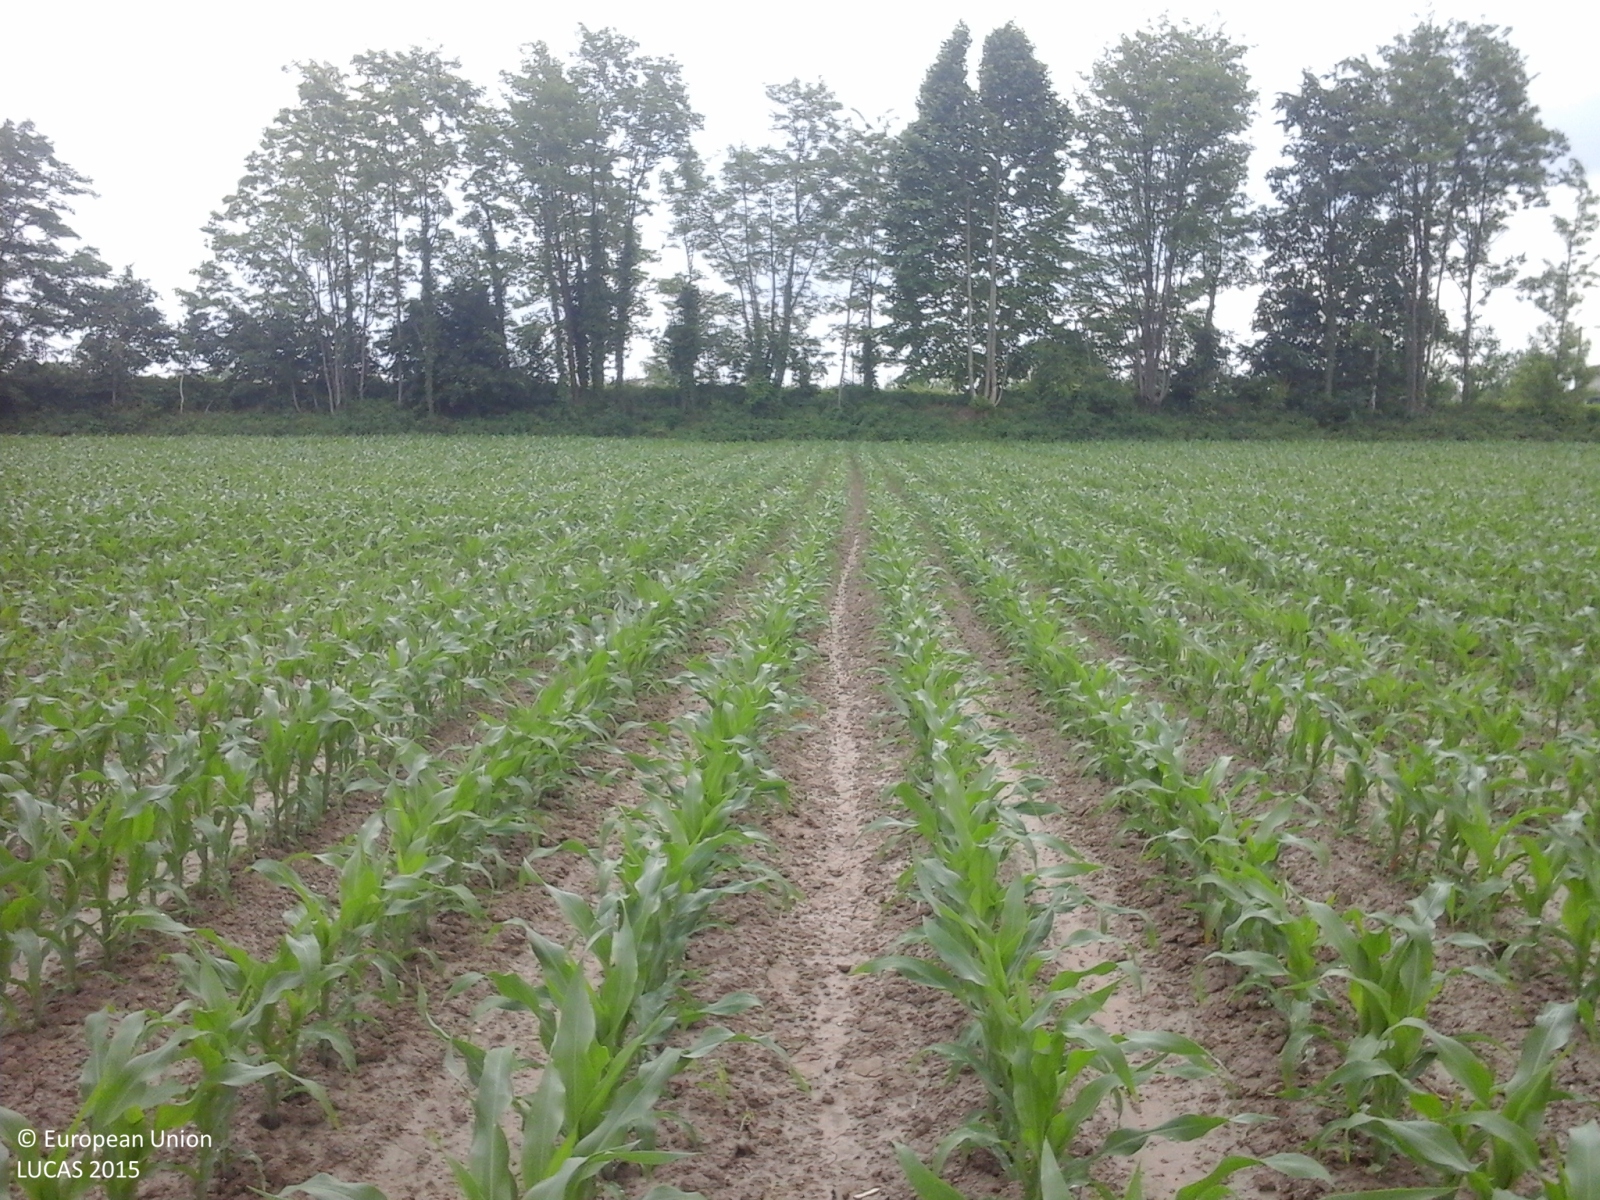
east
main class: Cropland
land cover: Maize
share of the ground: 25 - 50 %
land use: Agriculture (excluding fallow land and kitchen gardens)
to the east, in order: Maize; Tracks; Abandoned hedges; Tracks; Grassland without tree/shrub cover; Spontaneously vegetated surfaces; Electric lines; Spontaneously vegetated surfaces; Managed hedges; Ditches and canals; Electric lines; Grass margins; Paved roads, cycling and walking lanes; Grass margins; Maize
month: May
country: IT
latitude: 45.5611
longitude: 11.8036
